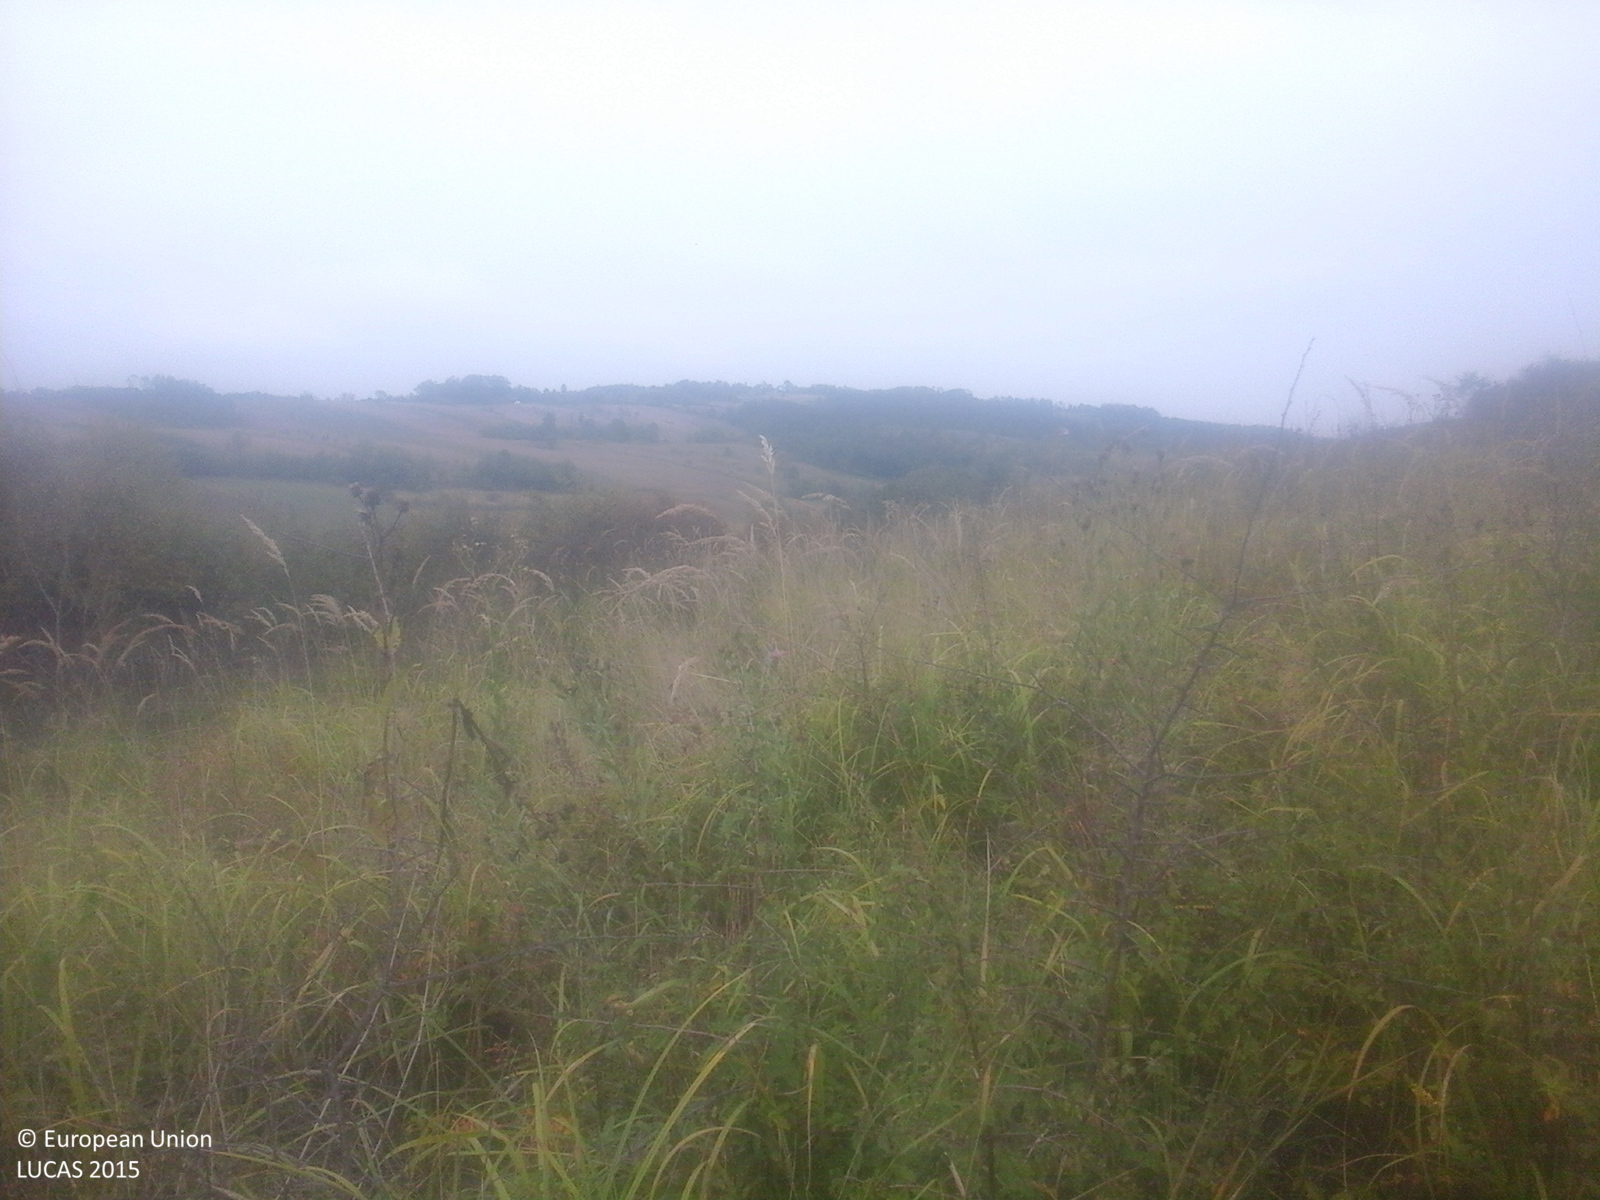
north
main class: Shrubland
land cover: Shrubland without tree cover
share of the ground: > 75 %
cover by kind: shrubs 60 %, herbaceous plants 40 %
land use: Fallow land
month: September
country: RO
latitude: 45.4815
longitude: 21.9225
